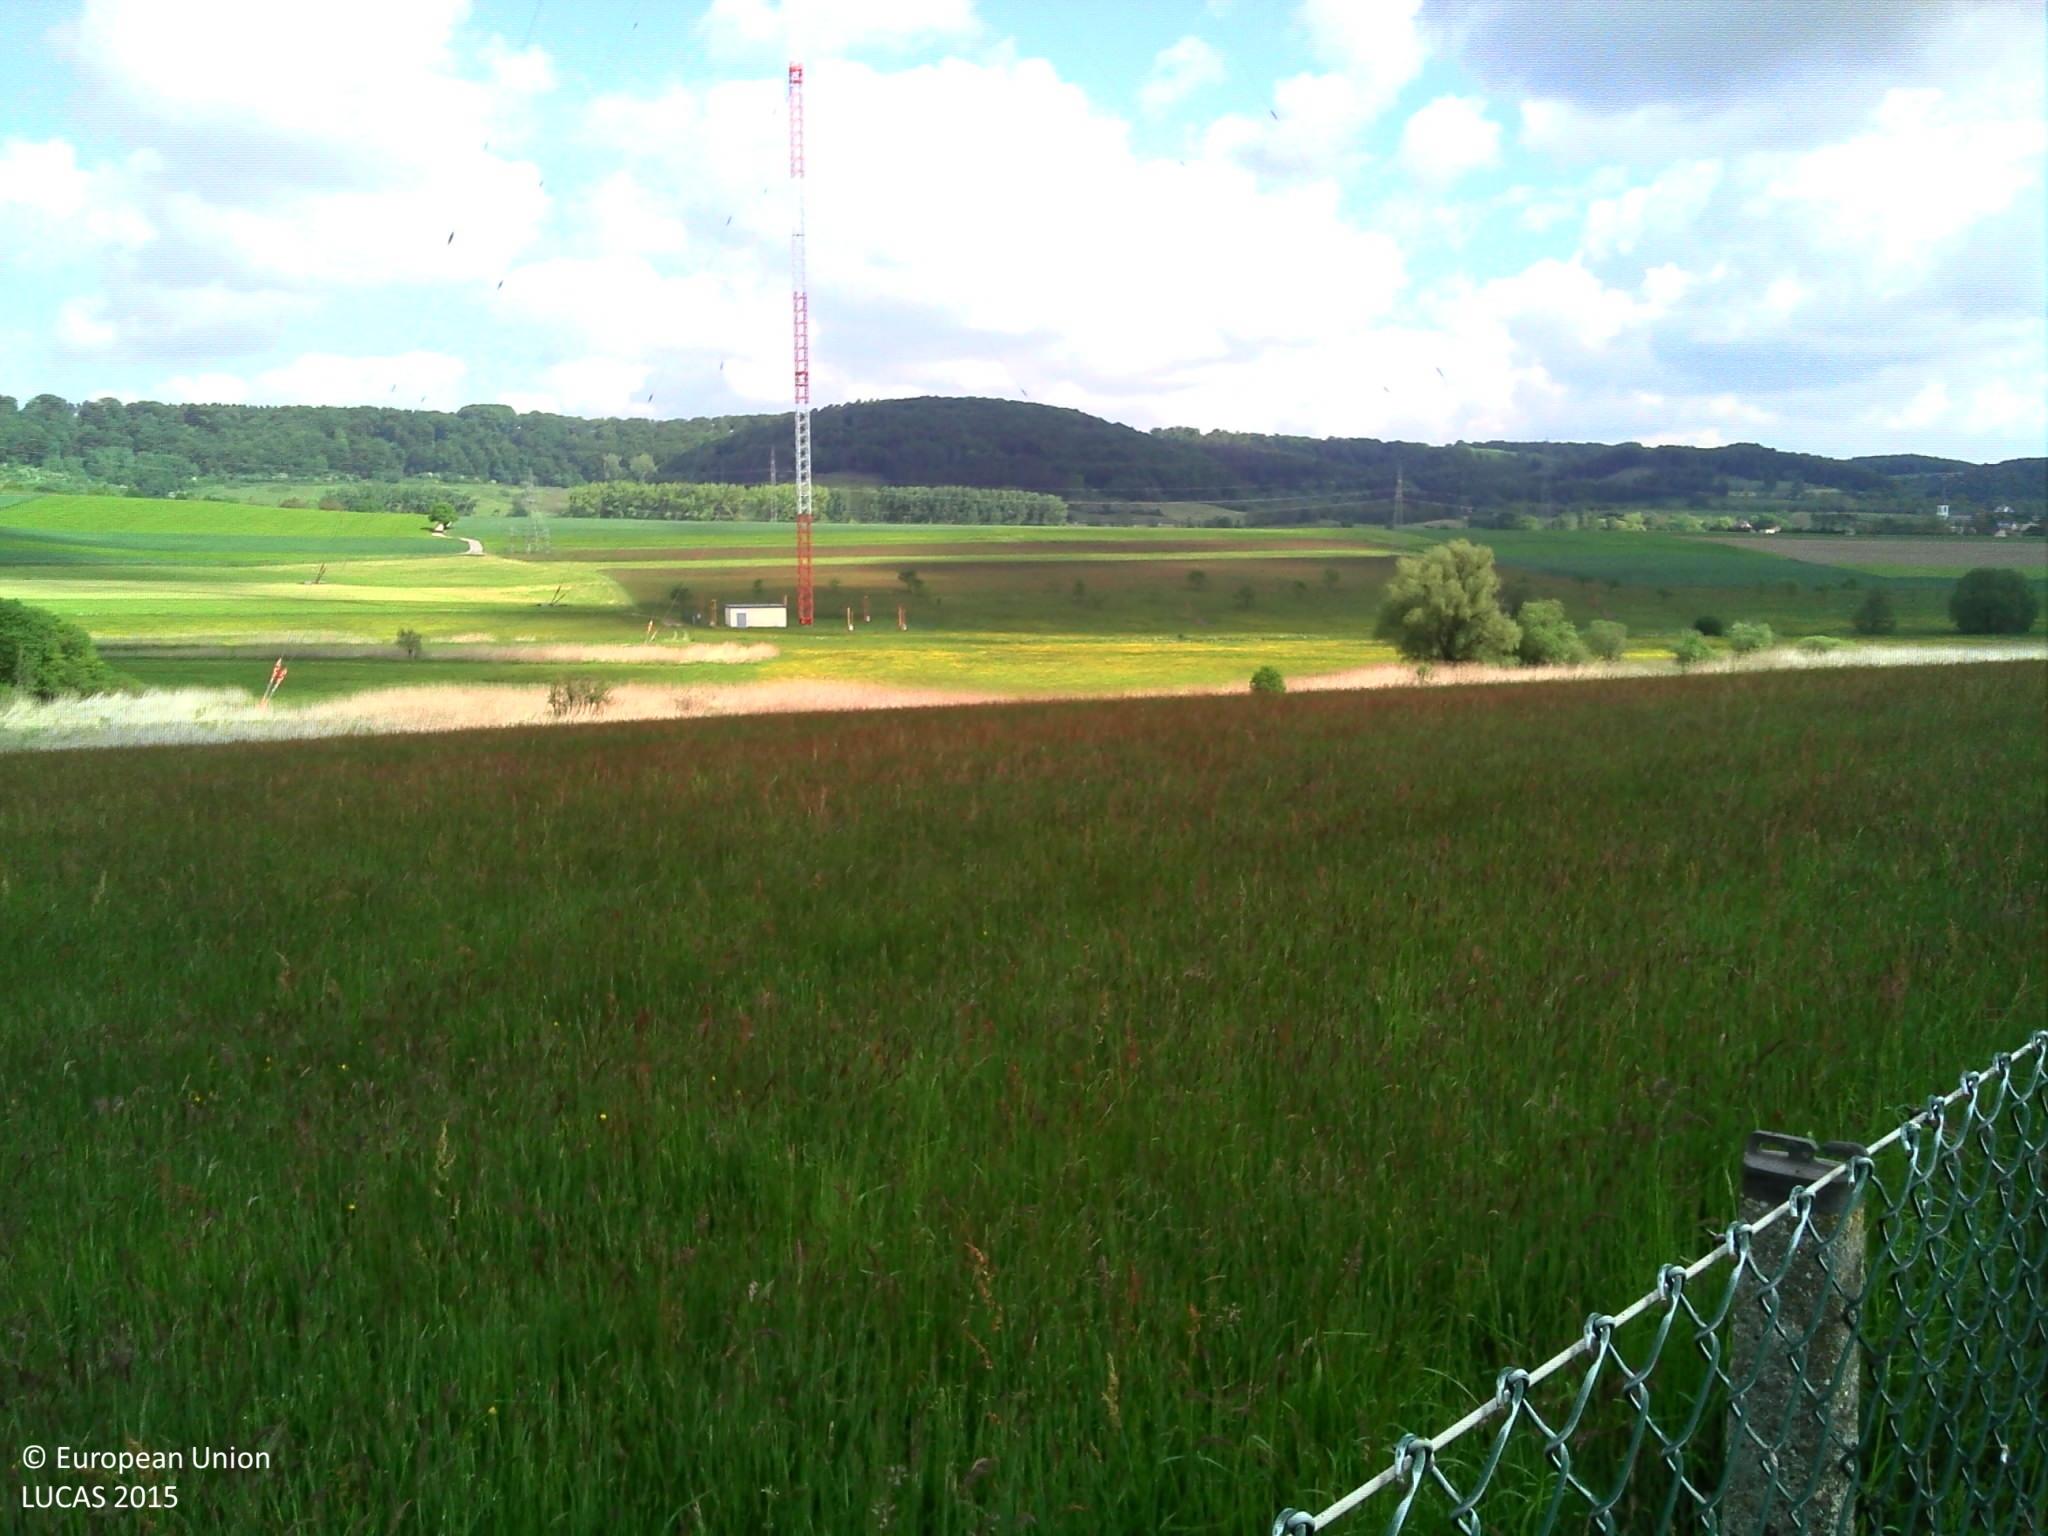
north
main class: Grassland
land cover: Grassland without tree/shrub cover
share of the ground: > 75 %
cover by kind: herbaceous plants 100 %
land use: Agriculture (excluding fallow land and kitchen gardens)
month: May
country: LU
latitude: 49.7289
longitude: 6.3232
